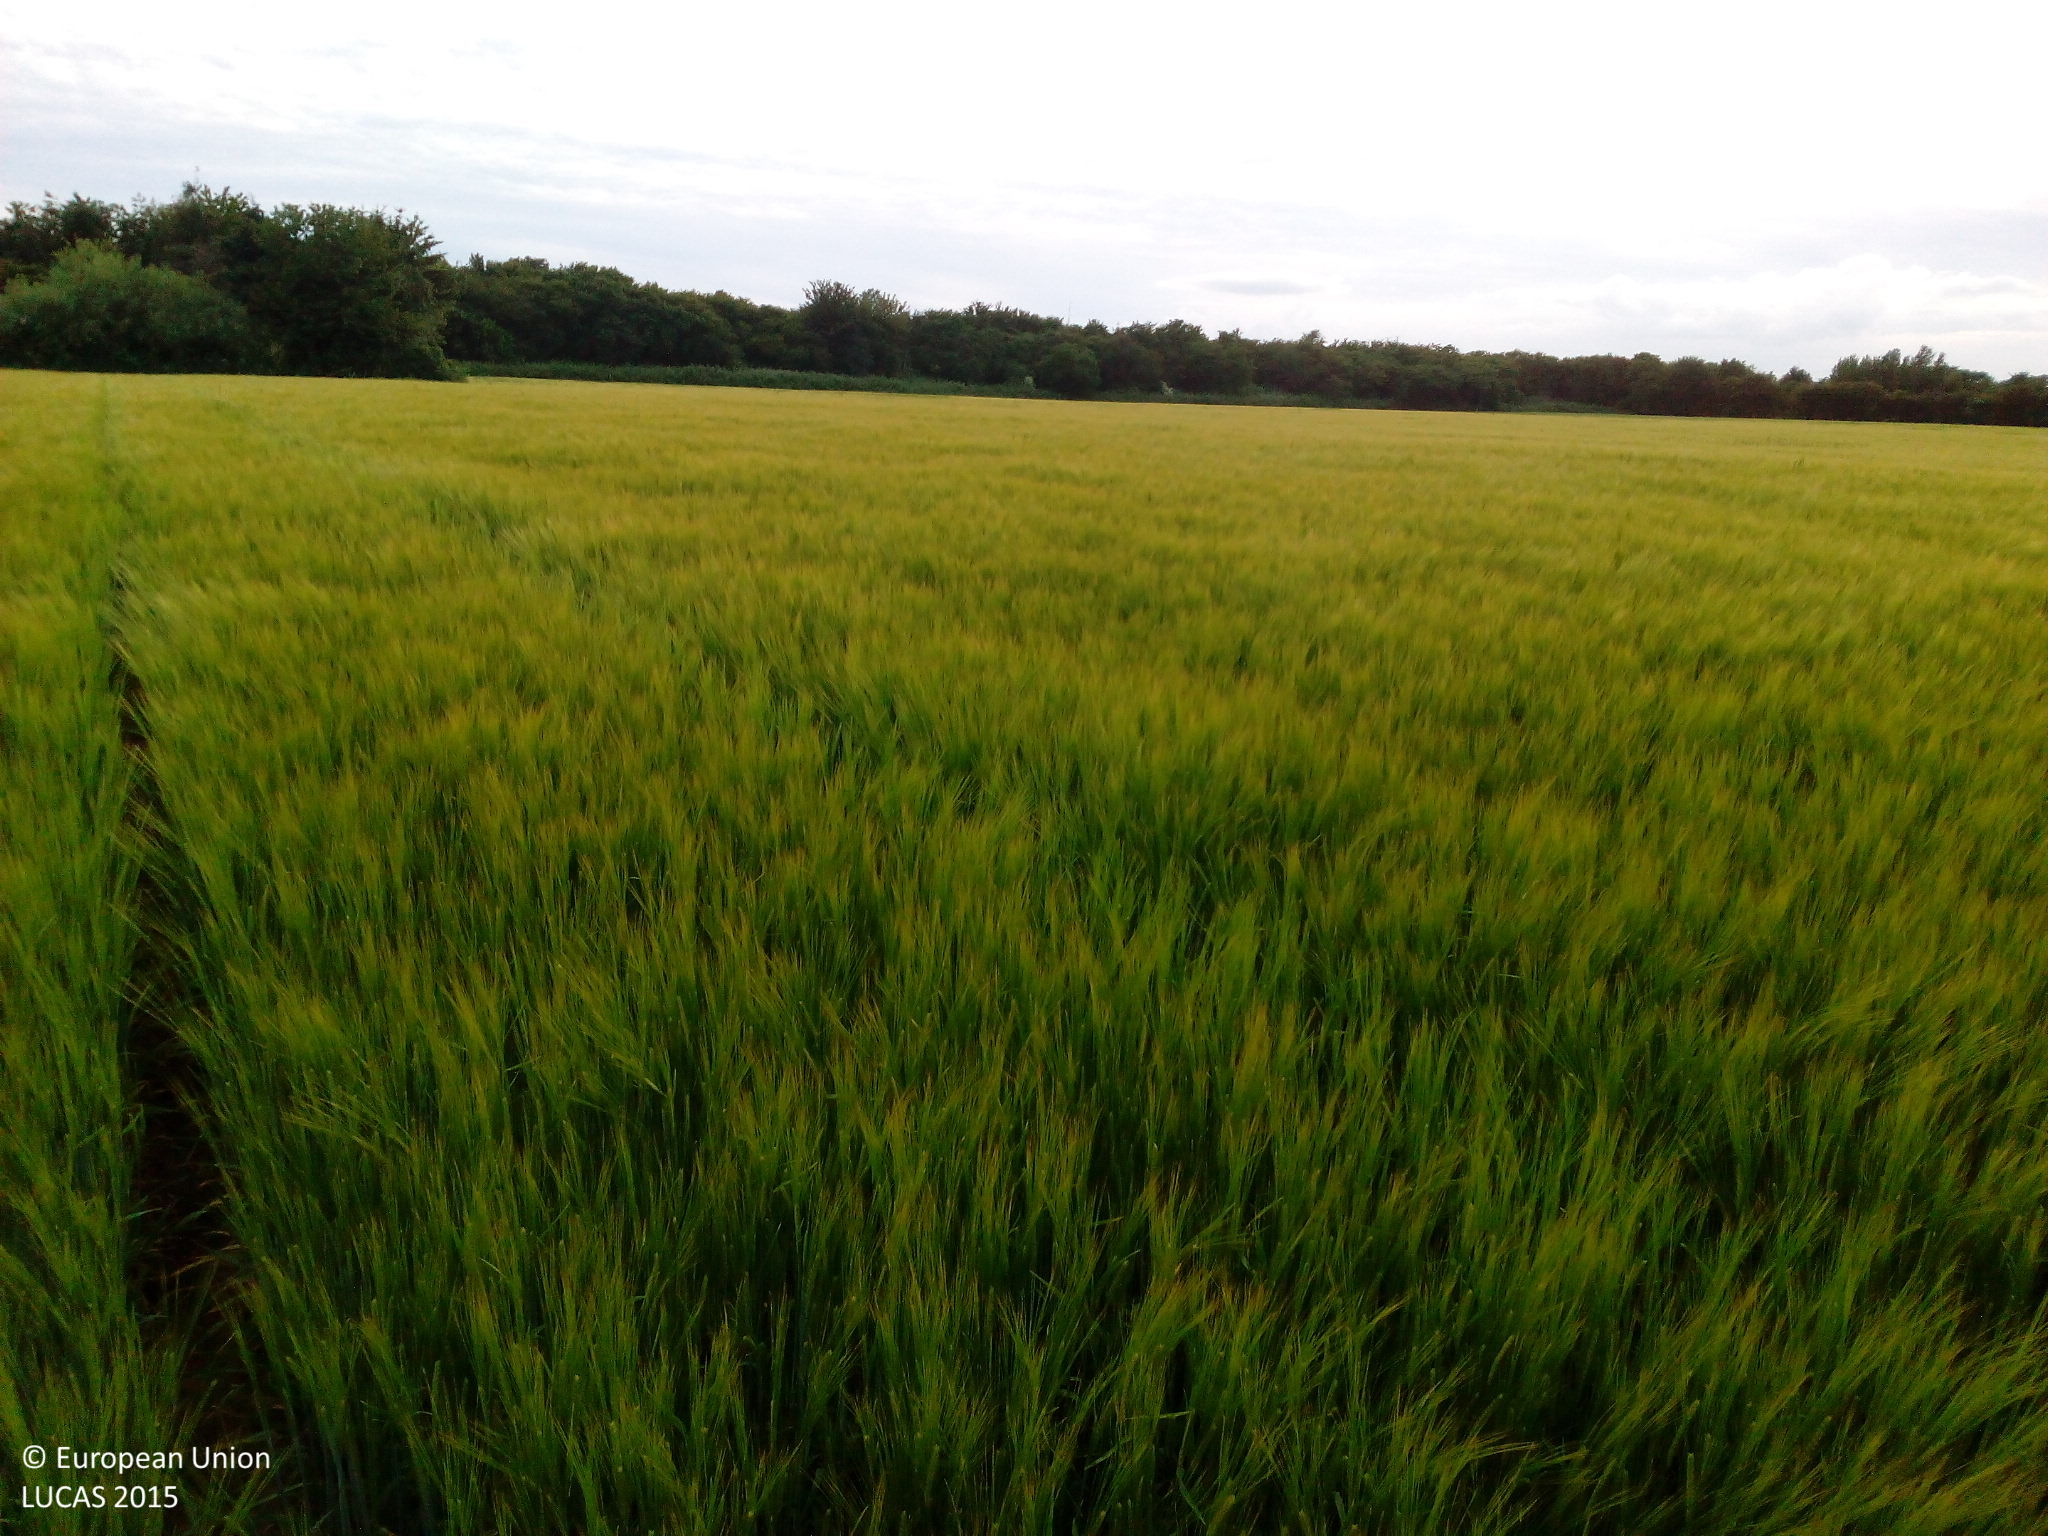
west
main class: Cropland
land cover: Barley
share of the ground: > 75 %
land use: Agriculture (excluding fallow land and kitchen gardens)
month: June
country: DK
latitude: 54.9872
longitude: 11.8897
